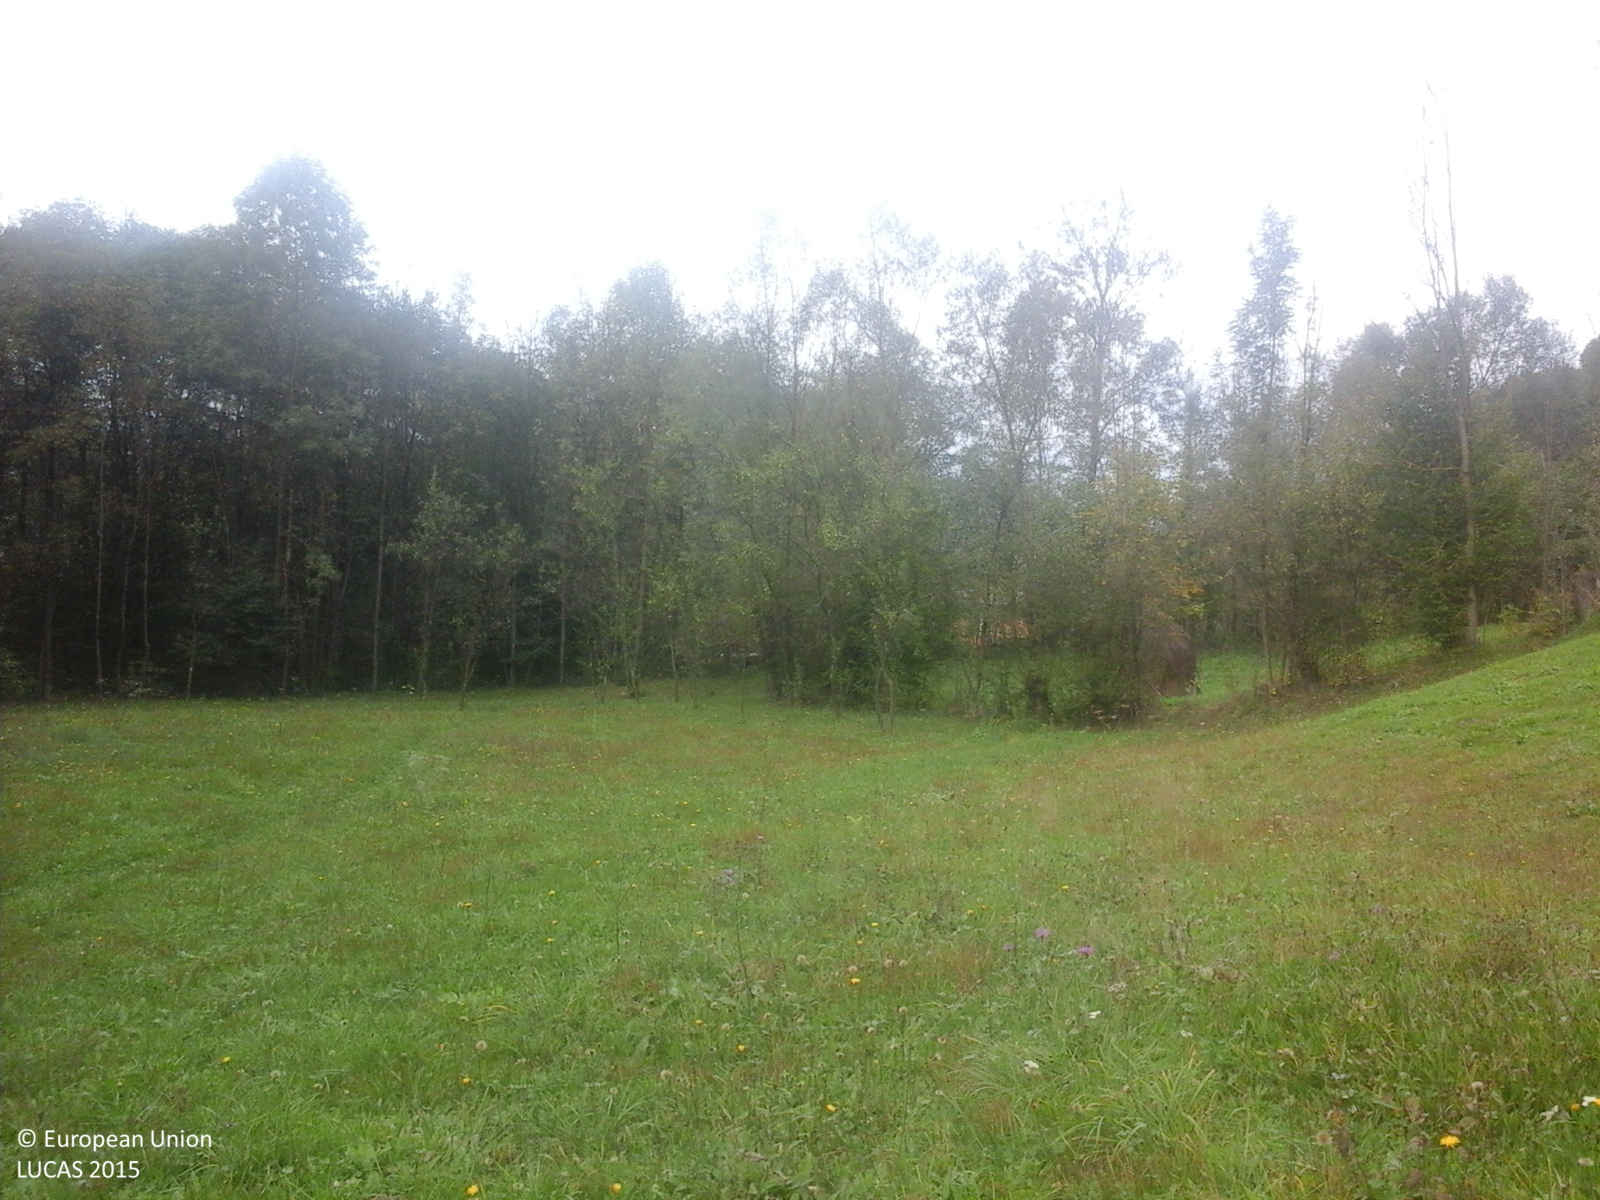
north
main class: Grassland
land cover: Grassland without tree/shrub cover
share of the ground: > 75 %
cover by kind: herbaceous plants 100 %
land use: Agriculture (excluding fallow land and kitchen gardens)
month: October
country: RO
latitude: 46.3530
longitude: 23.1734
